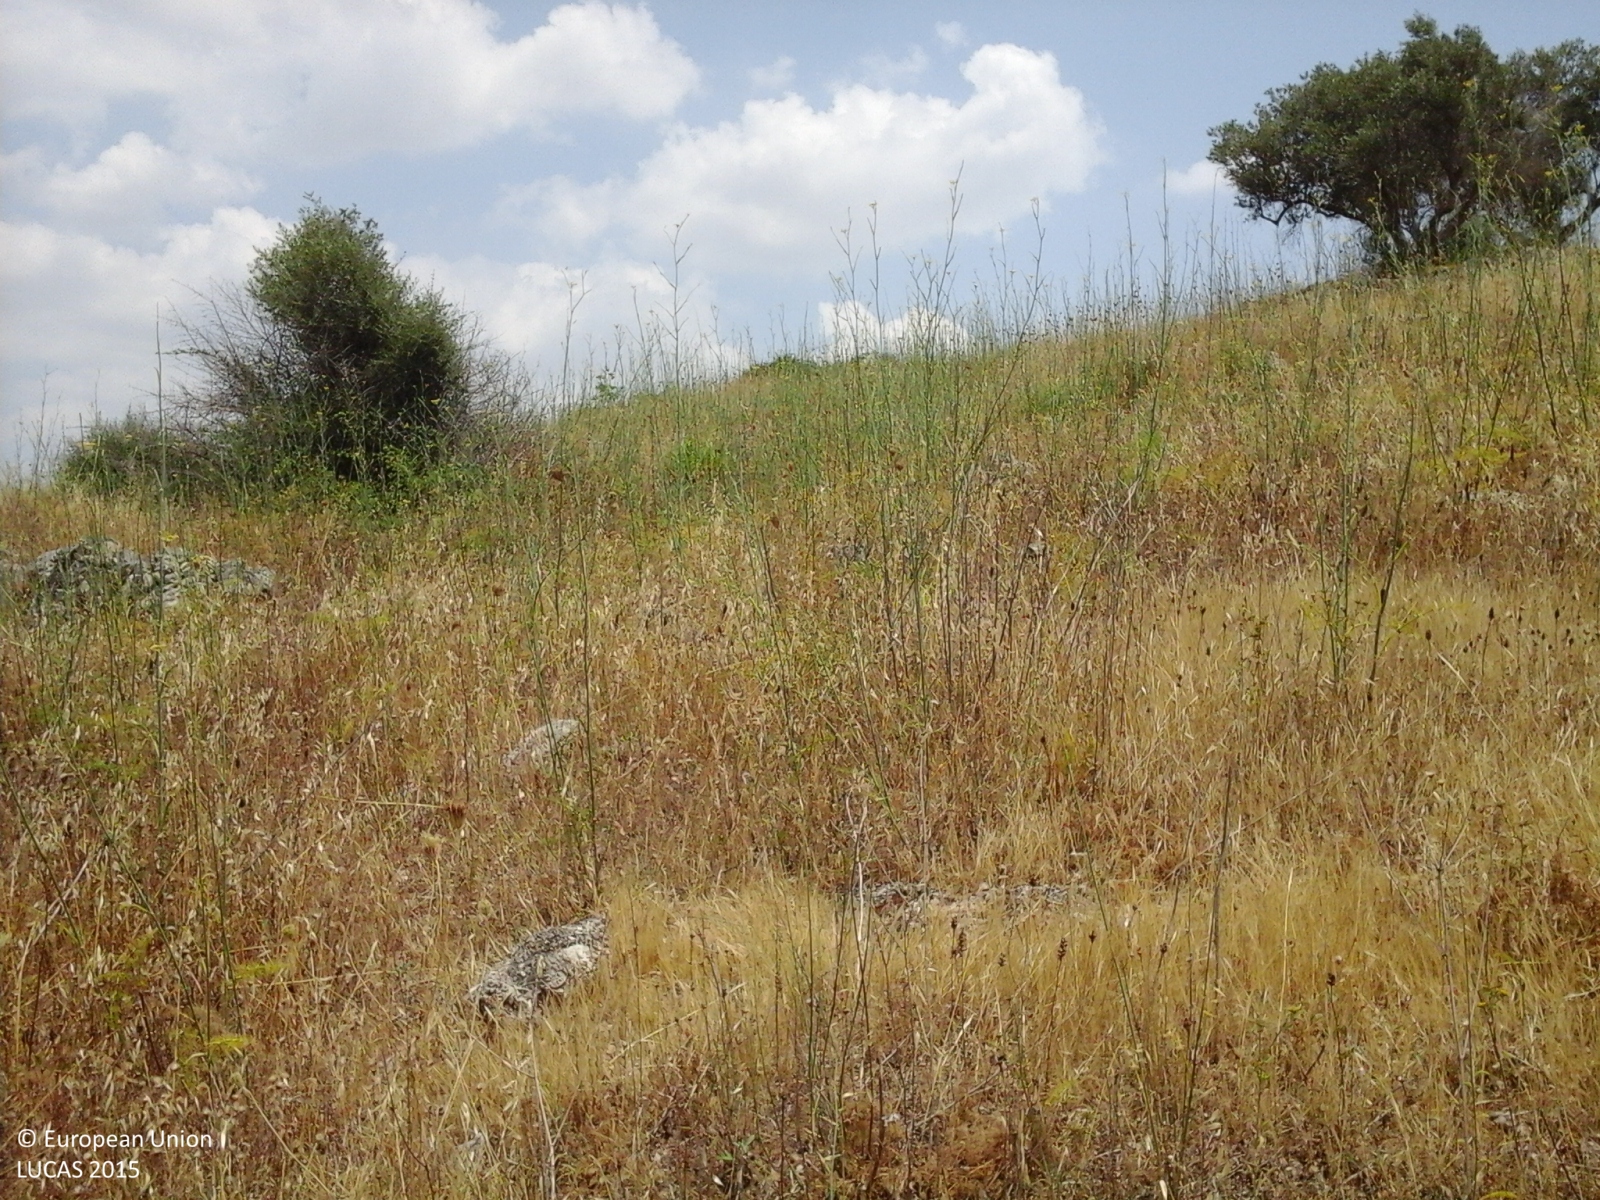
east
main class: Grassland
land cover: Grassland with sparse tree/shrub cover
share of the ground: > 75 %
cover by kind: herbaceous plants 85 %, shrubs 10 %, coniferous forest trees 5 %
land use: Semi-natural and natural areas not in use
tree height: > 5 m
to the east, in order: Grassland with sparse tree/shrub cover; Spontaneously vegetated surfaces; Abandoned hedges; Spontaneously vegetated surfaces; Tracks; Spontaneously vegetated surfaces; Dry stone walls; Paved roads, cycling and walking lanes; Dry stone walls; Grass margins; Olive groves; Nuts trees; Grass margins; Vineyards
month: July
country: IT
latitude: 37.2837
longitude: 13.9509
